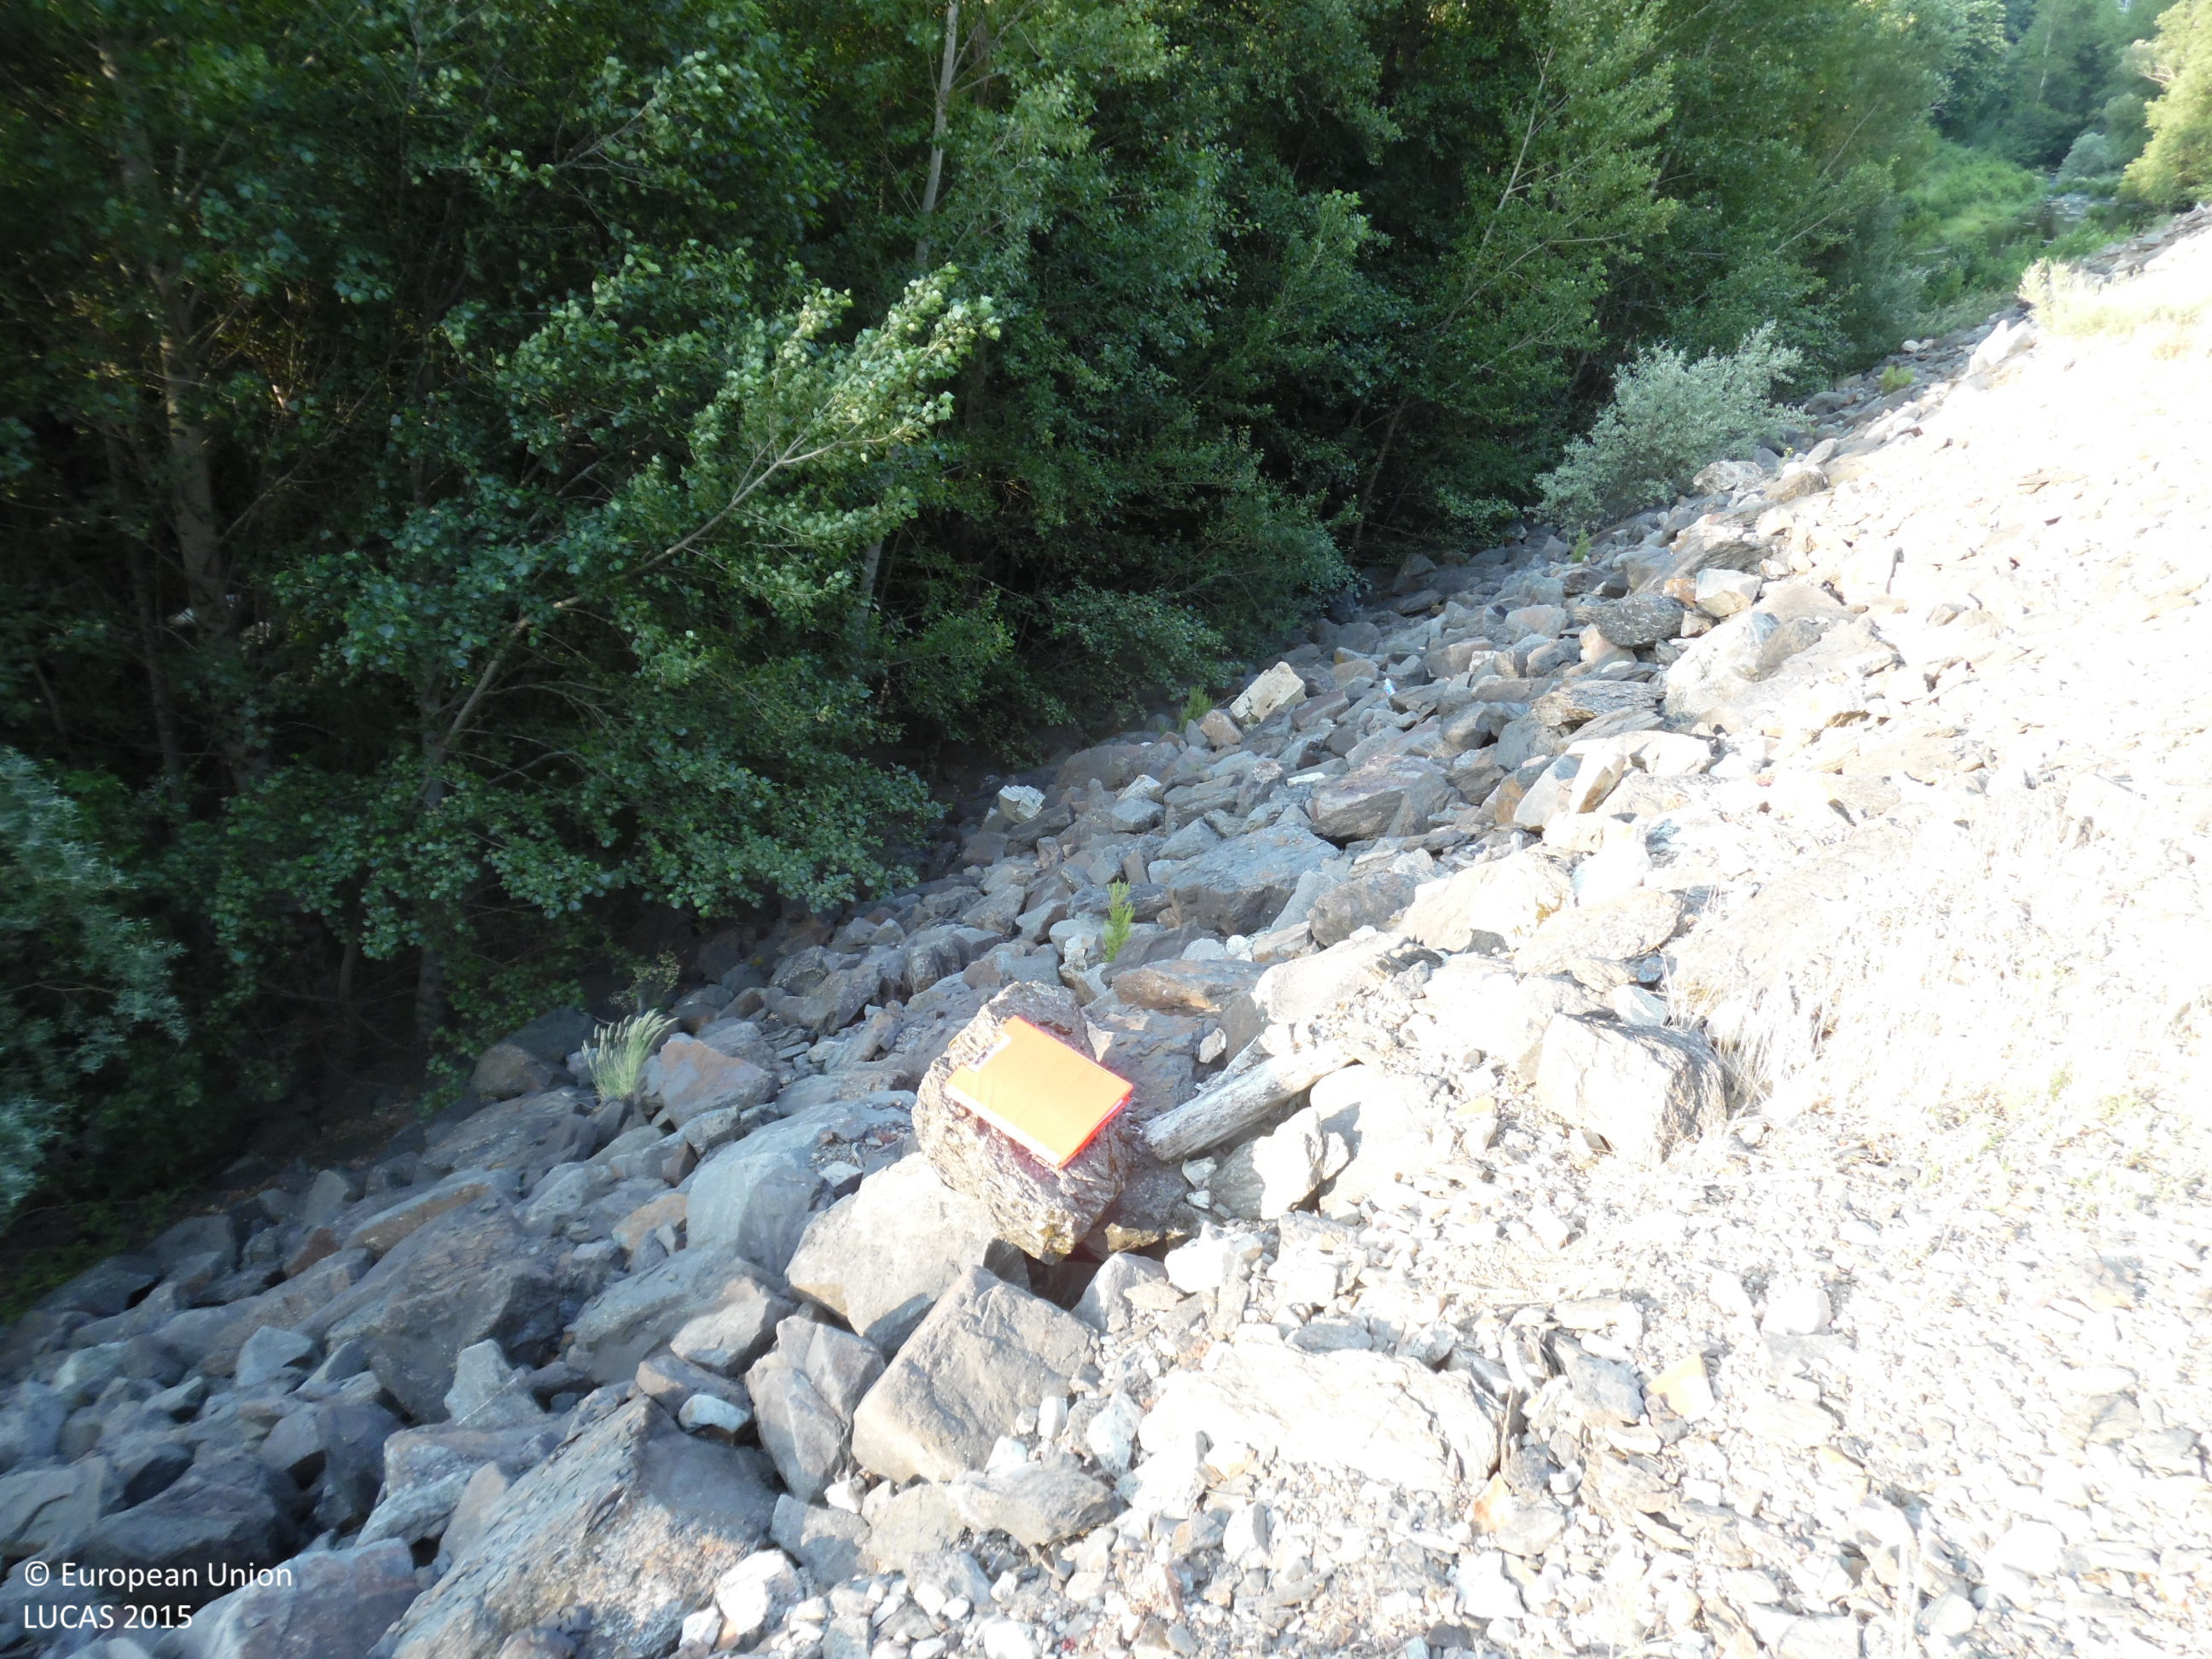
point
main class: Woodland
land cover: Broadleaved woodland
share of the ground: > 75 %
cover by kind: broadleaved forest trees 80 %, shrubs 5 %
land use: Forestry
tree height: > 5 m
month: June
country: ES
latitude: 42.8383
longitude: -6.4783
